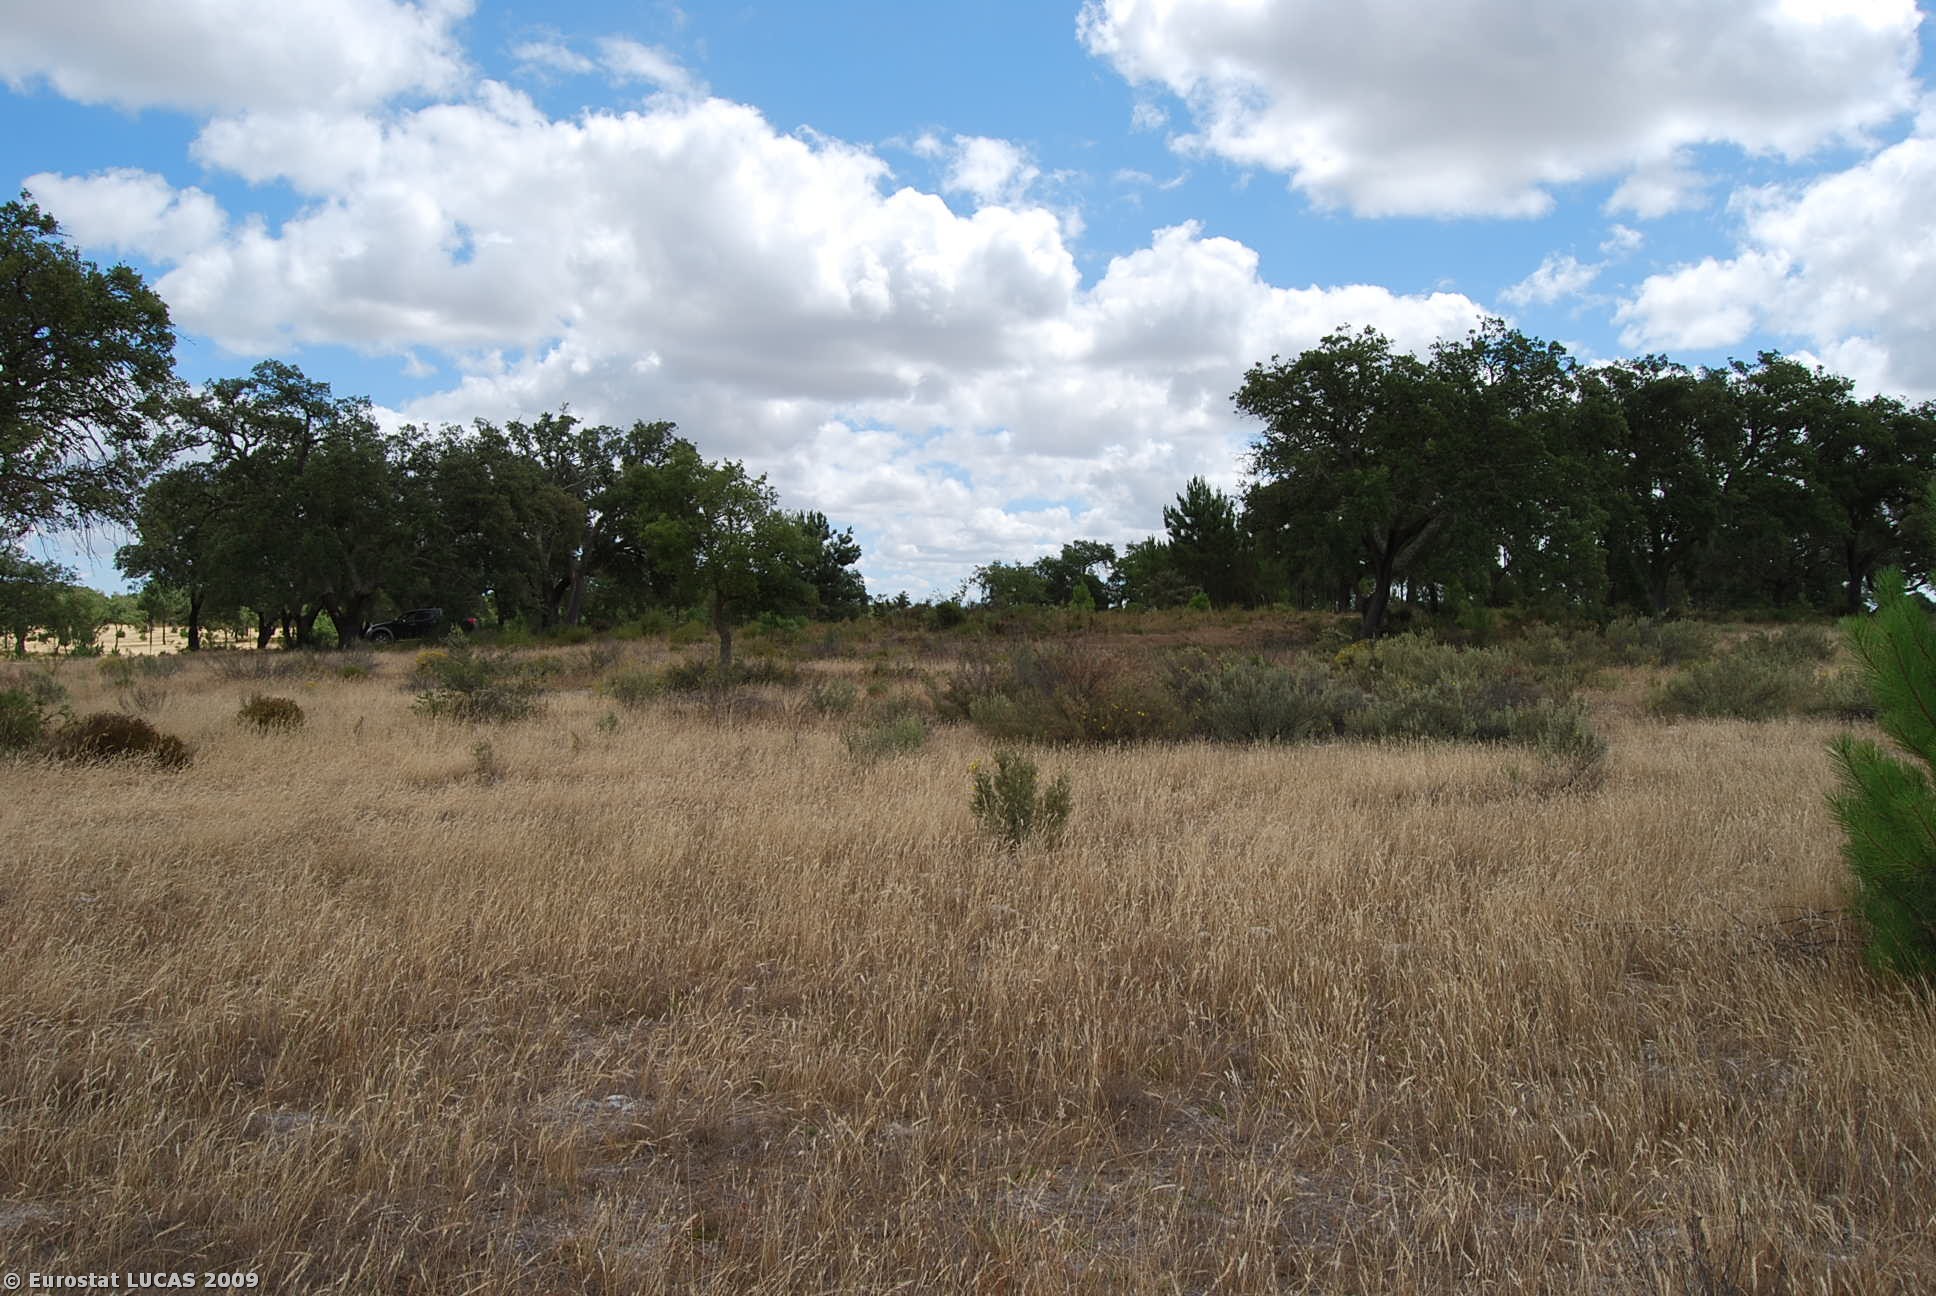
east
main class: Woodland
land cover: Mixed woodland
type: broadleaved evergreen forest
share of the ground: 10 - 25 %
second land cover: Grassland with sparse tree/shrub cover
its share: > 75 %
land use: Forestry
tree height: > 5 m
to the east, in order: Mixed woodland; Grassland with sparse tree/shrub cover; Tracks; Other structural elements; Fences; Bare land; Mixed woodland
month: June
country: PT
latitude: 37.9379
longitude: -8.4857
